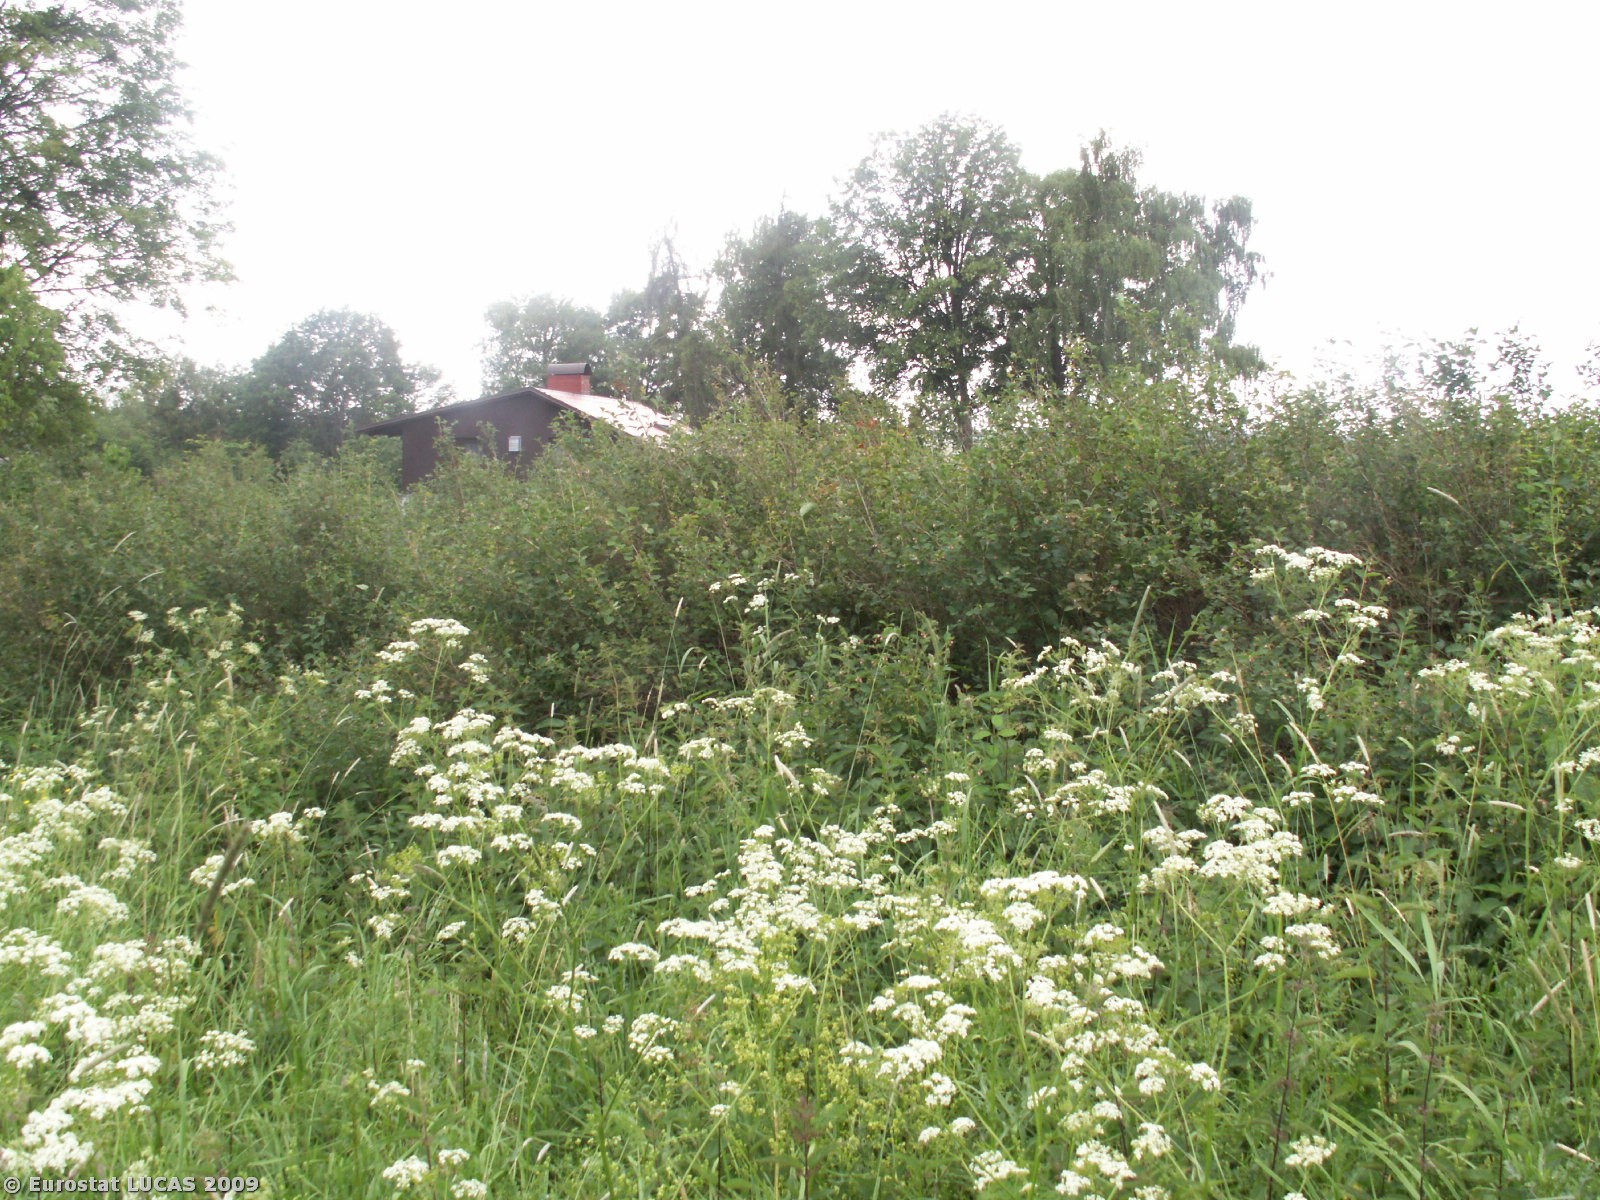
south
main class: Grassland
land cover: Spontaneously vegetated surfaces
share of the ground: > 75 %
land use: Fallow land
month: June
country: CZ
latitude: 50.1625
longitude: 13.0096
